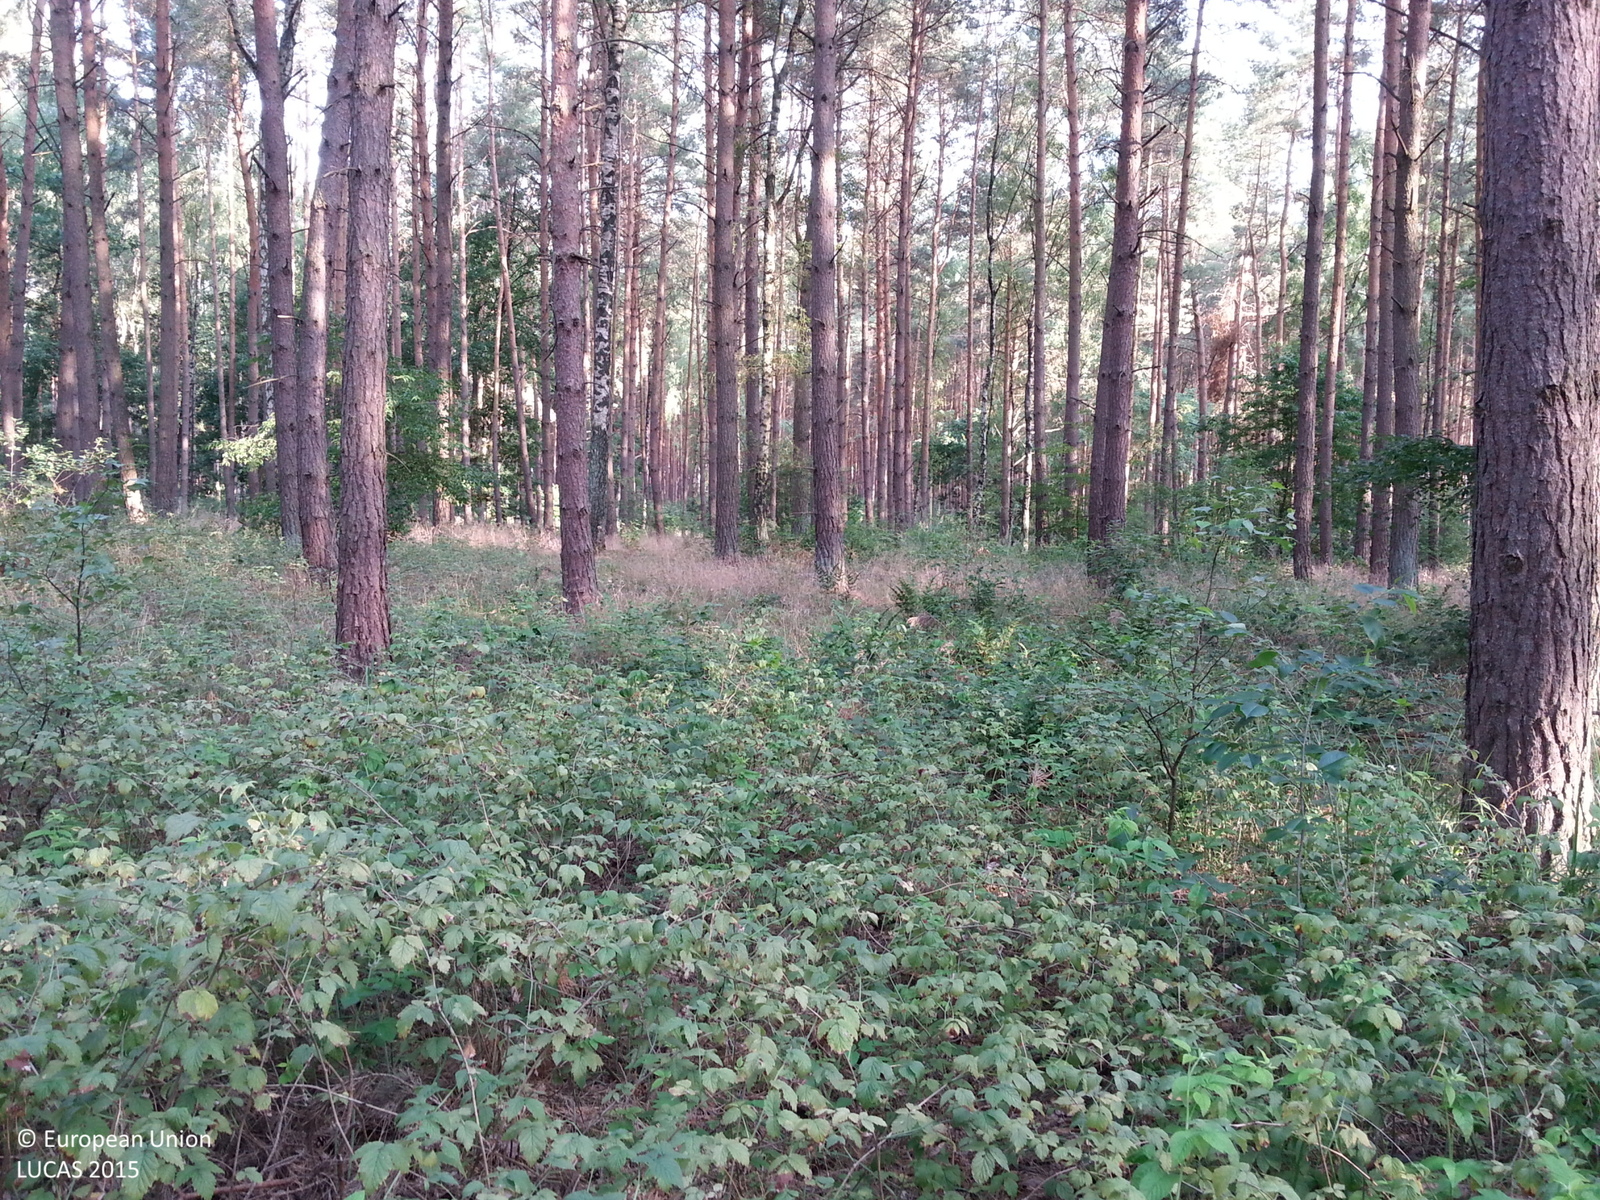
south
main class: Woodland
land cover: Pine dominated coniferous woodland
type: hemiboreal forest and nemoral coniferous forest and mixed broadleaved-coniferous forest
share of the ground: 50 - 75 %
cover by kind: coniferous forest trees 60 %, shrubs 35 %, lichens and mosses 5 %
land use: Forestry
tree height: > 5 m
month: July
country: DE
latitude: 52.9424
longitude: 12.6037
